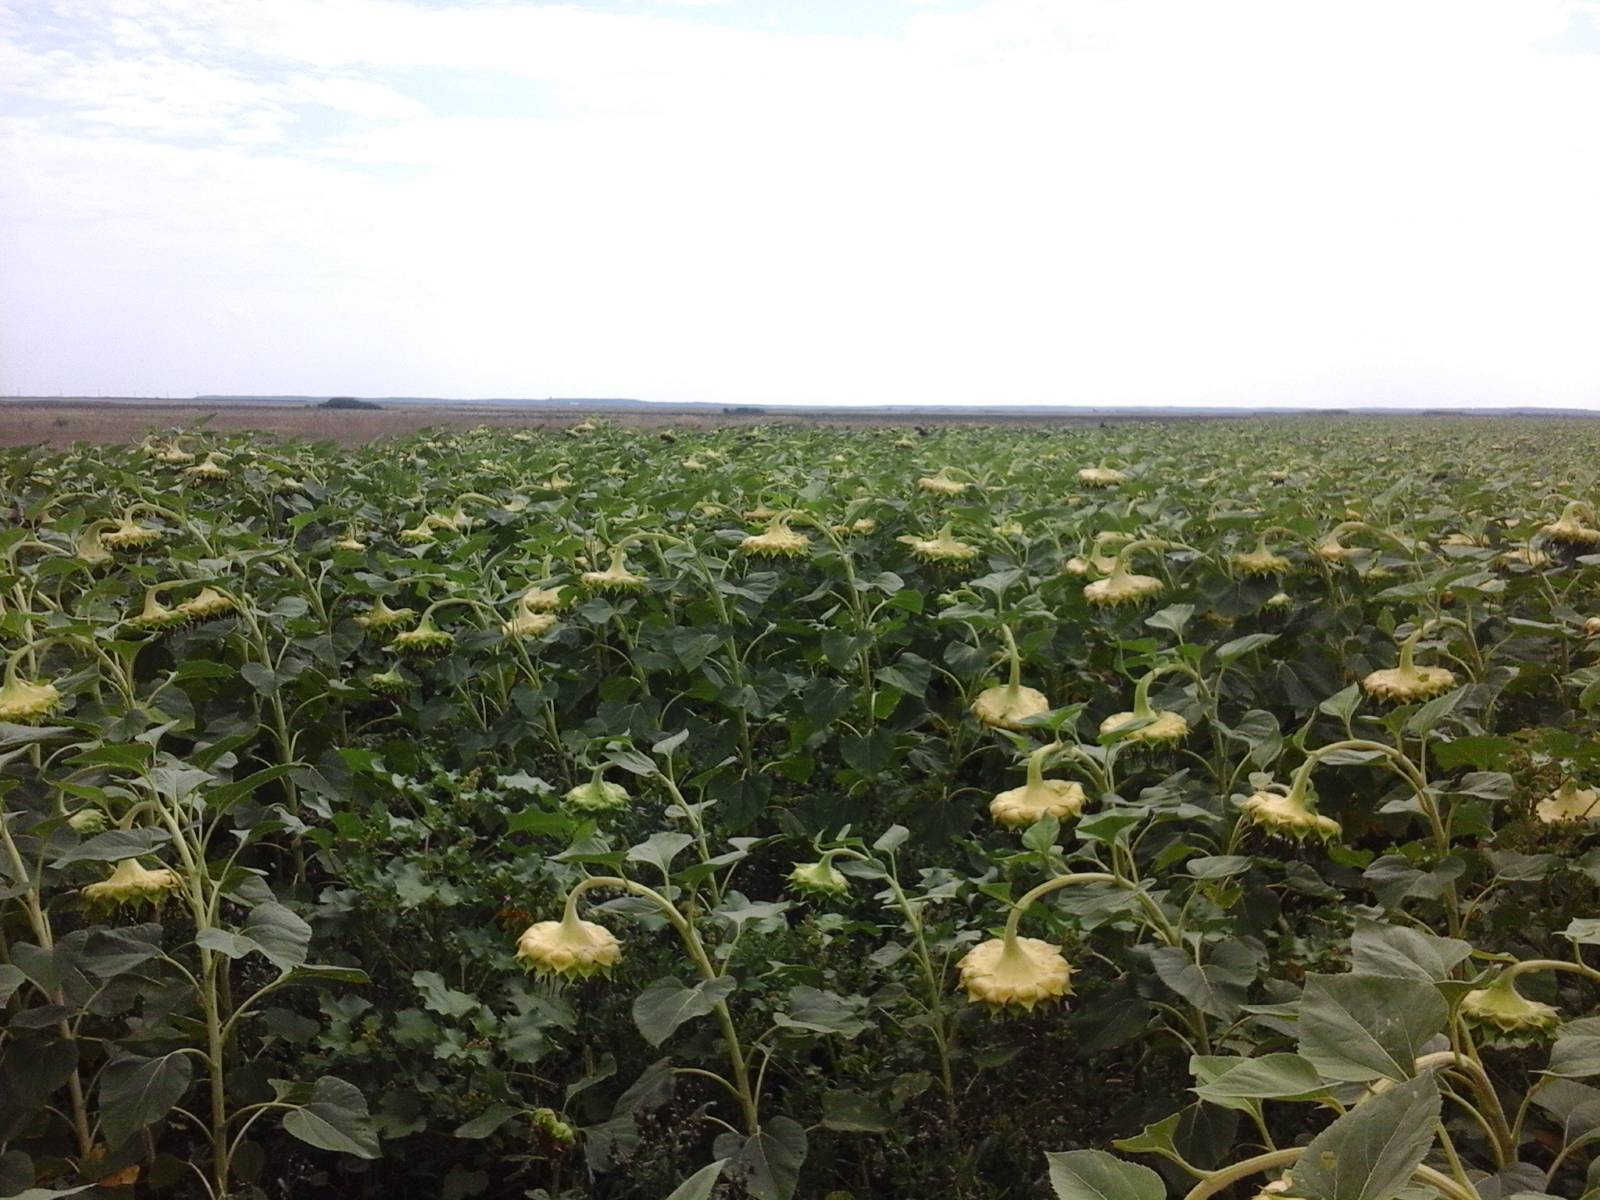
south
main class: Cropland
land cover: Sunflower
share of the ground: > 75 %
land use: Agriculture (excluding fallow land and kitchen gardens)
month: August
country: RO
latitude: 46.6207
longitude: 21.4912
